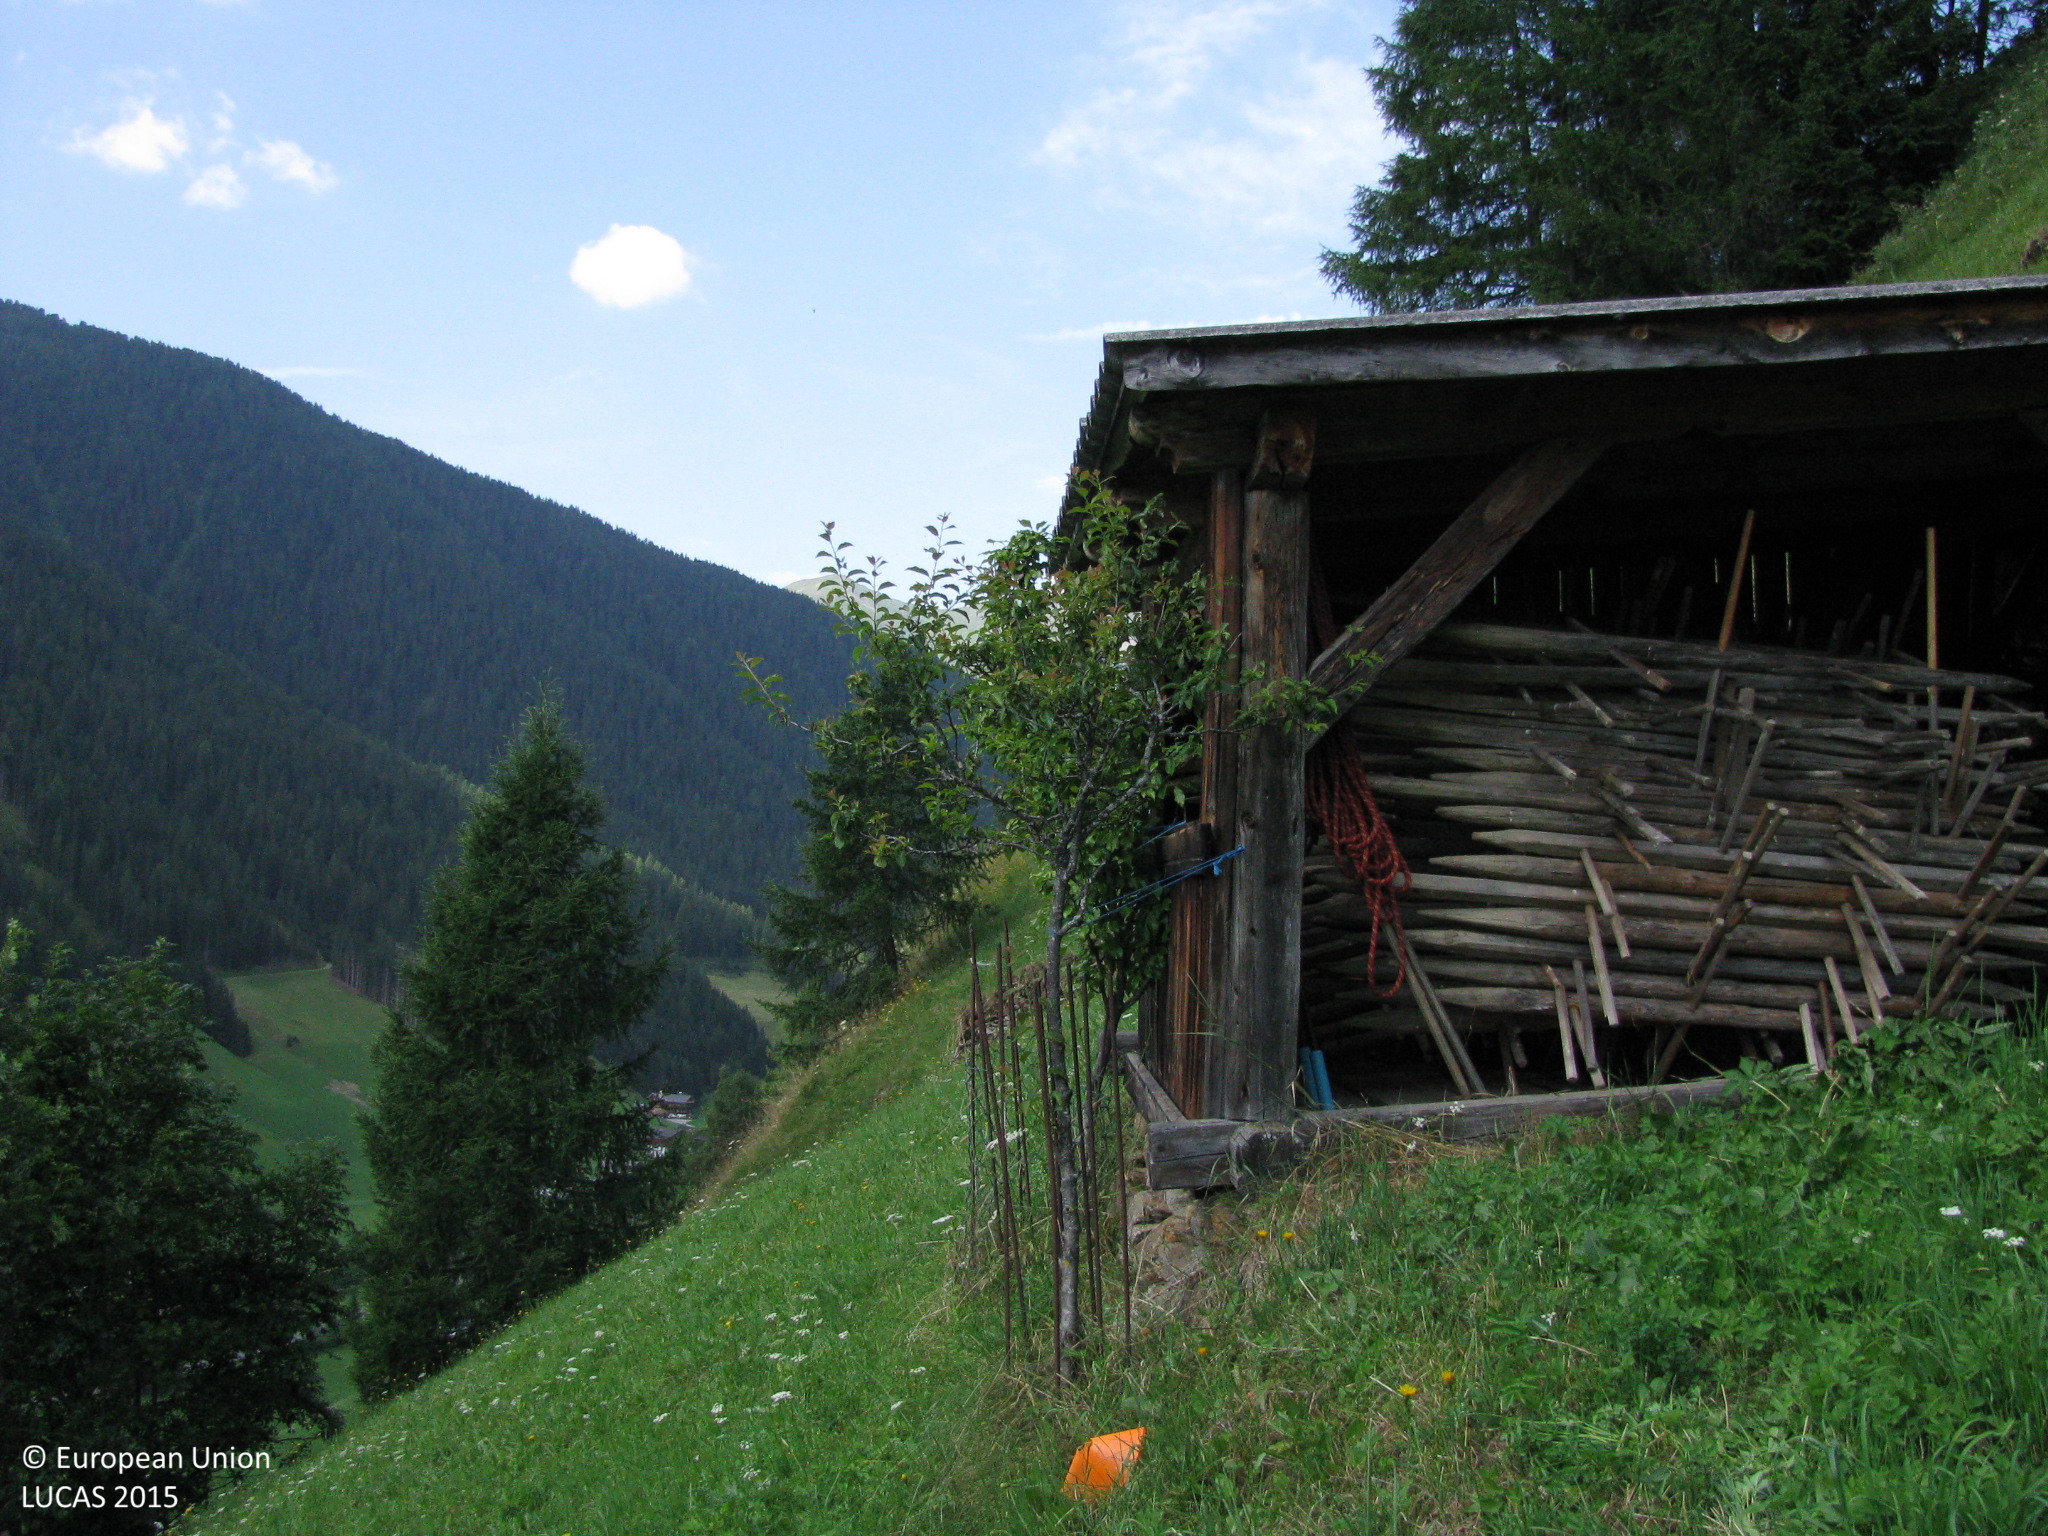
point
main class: Grassland
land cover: Grassland with sparse tree/shrub cover
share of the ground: > 75 %
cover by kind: herbaceous plants 95 %, broadleaved forest trees 5 %
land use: Agriculture (excluding fallow land and kitchen gardens)
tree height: < 5 m
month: July
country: AT
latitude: 46.8114
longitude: 12.3698
